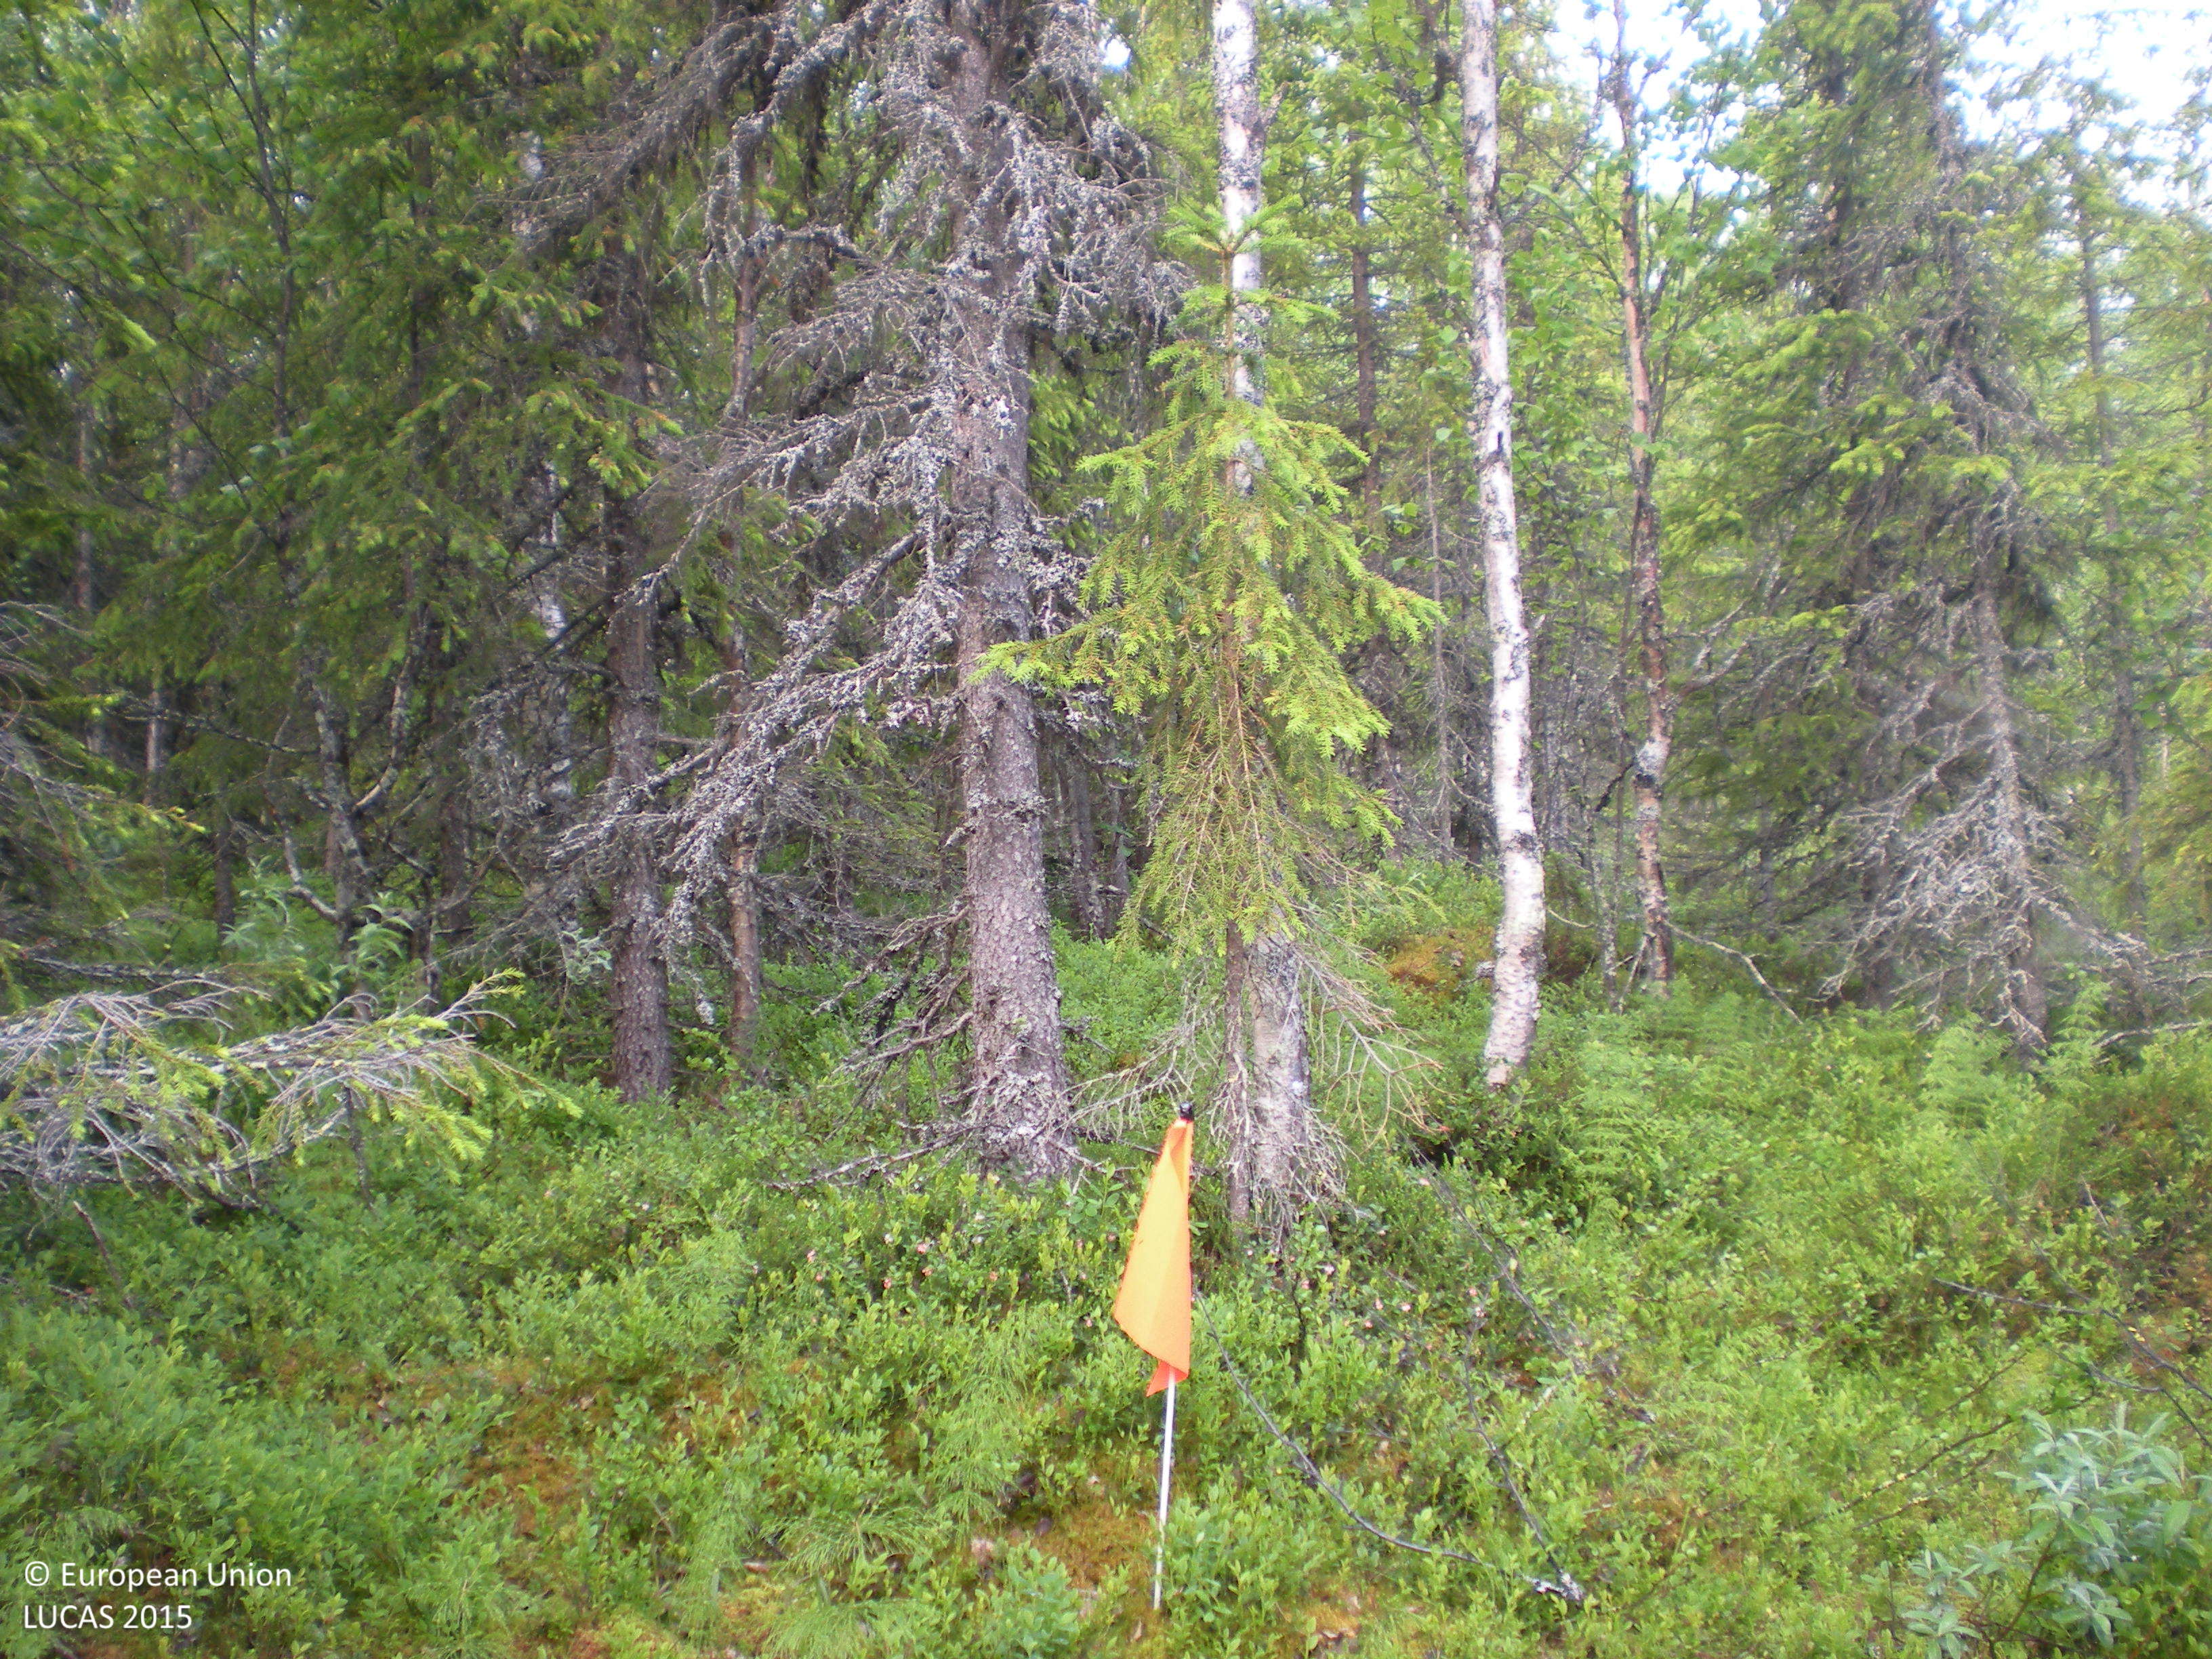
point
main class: Woodland
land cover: Spruce dominated mixed woodland
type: boreal forest
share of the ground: 50 - 75 %
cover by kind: coniferous forest trees 45 %, broadleaved forest trees 25 %, shrubs 20 %, lichens and mosses 10 %
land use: Forestry
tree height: > 5 m
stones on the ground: > 50 %
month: July
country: SE
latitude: 65.4911
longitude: 17.1112
